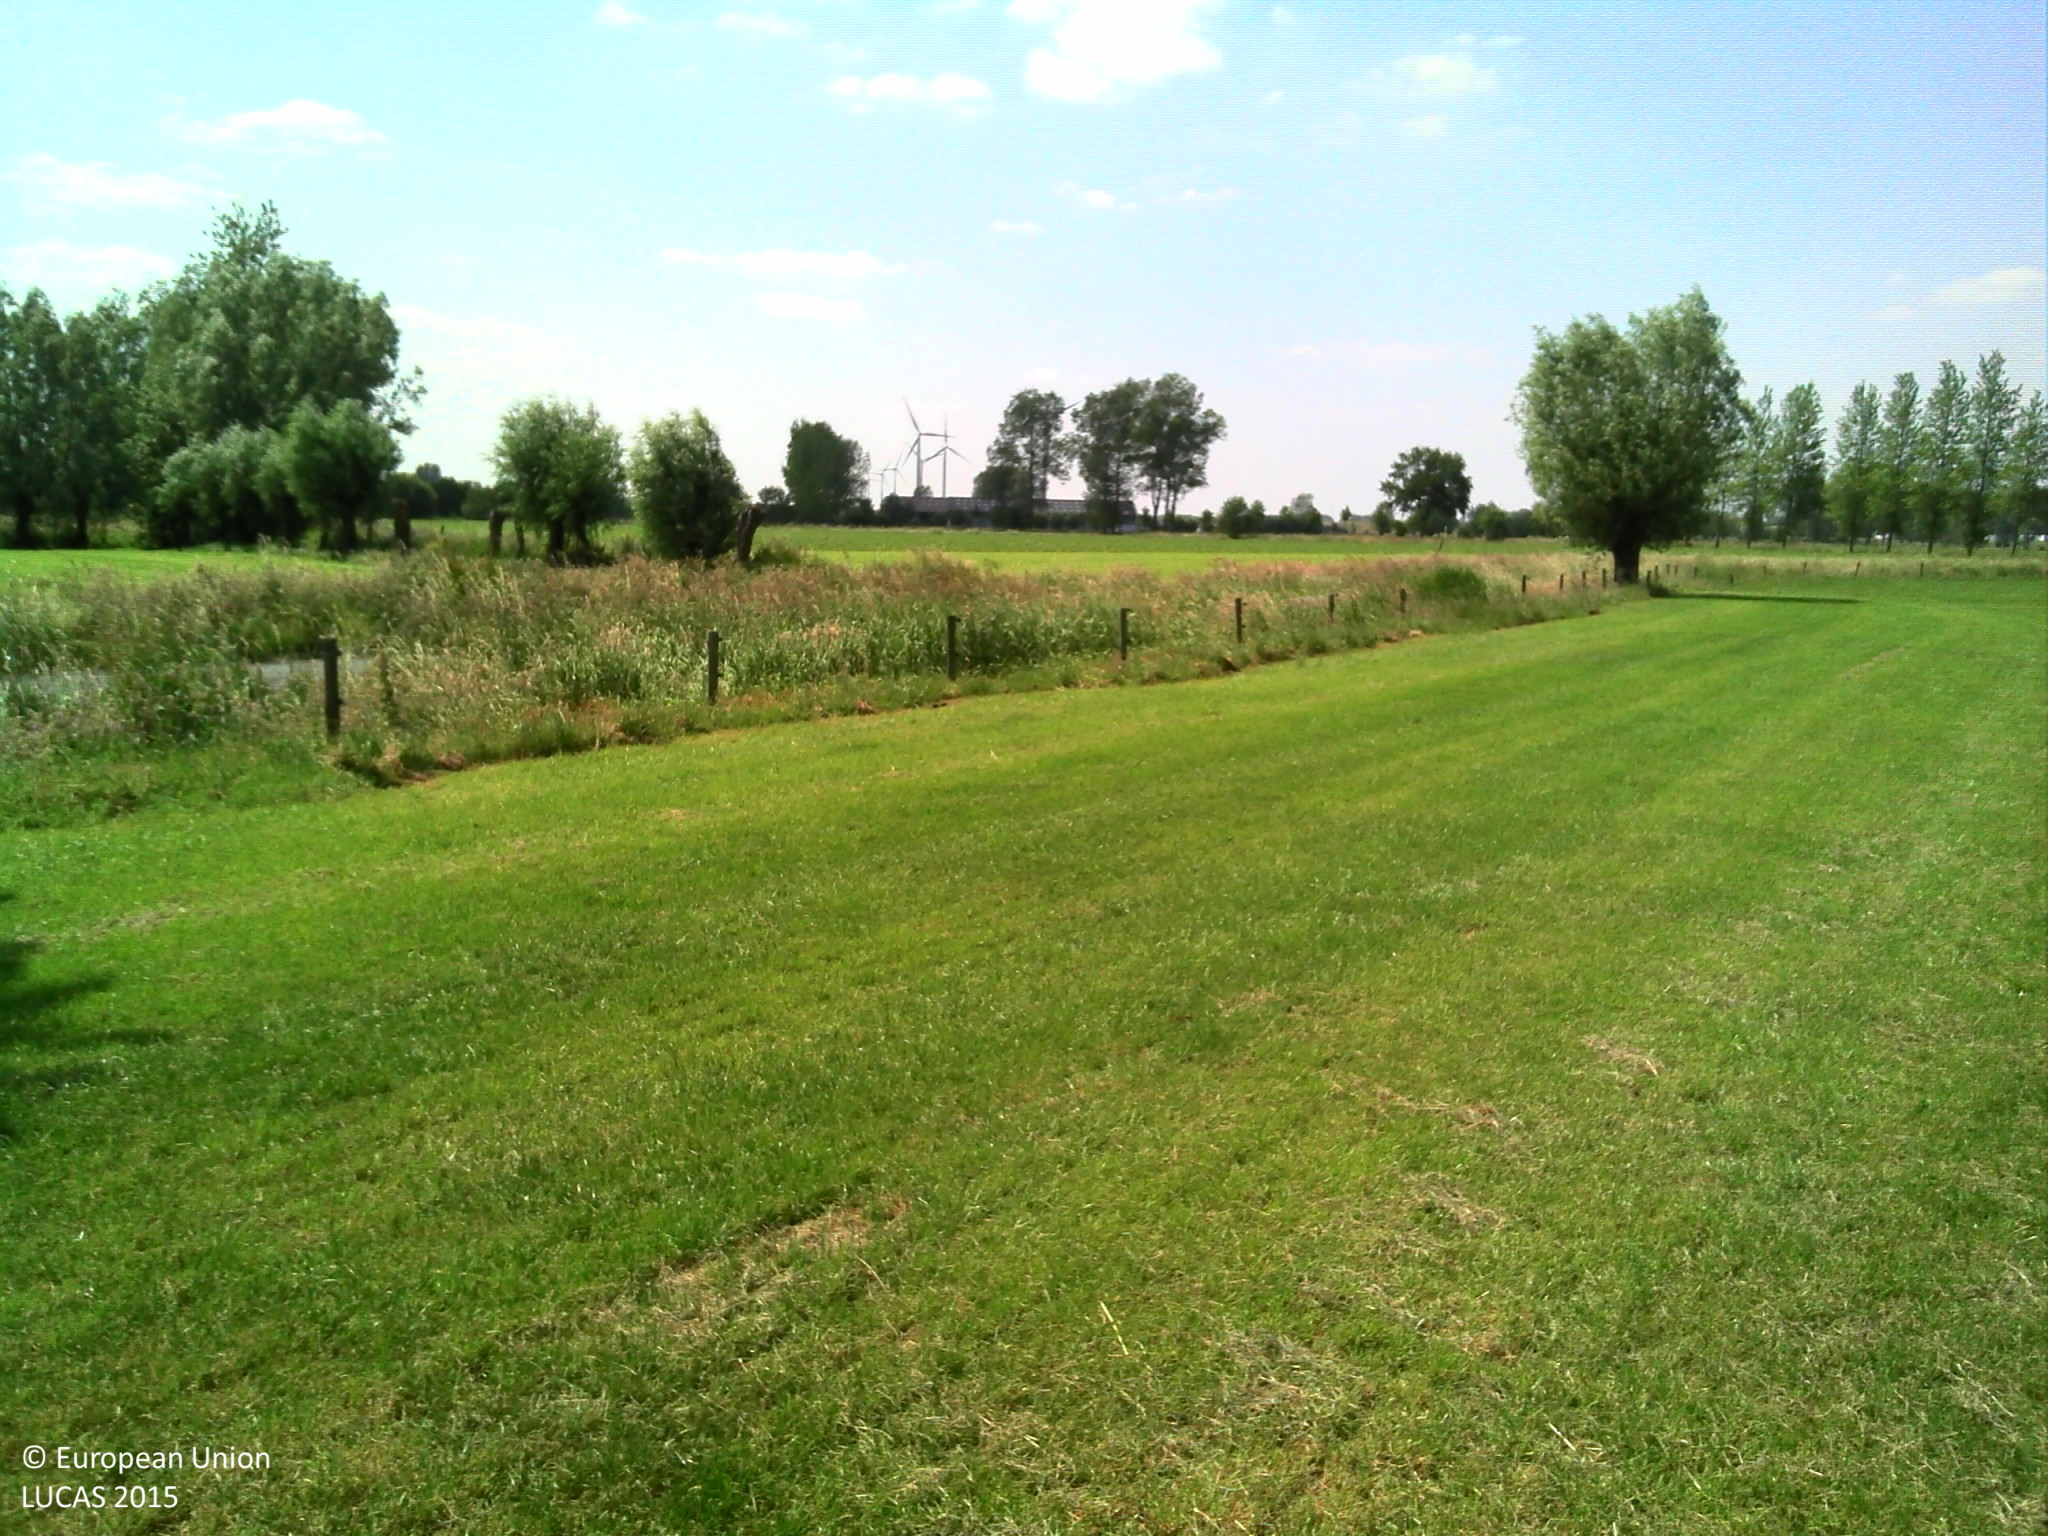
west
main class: Grassland
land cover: Grassland without tree/shrub cover
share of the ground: > 75 %
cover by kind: herbaceous plants 100 %
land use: Agriculture (excluding fallow land and kitchen gardens)
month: June
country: BE
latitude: 51.0727
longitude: 4.0142
